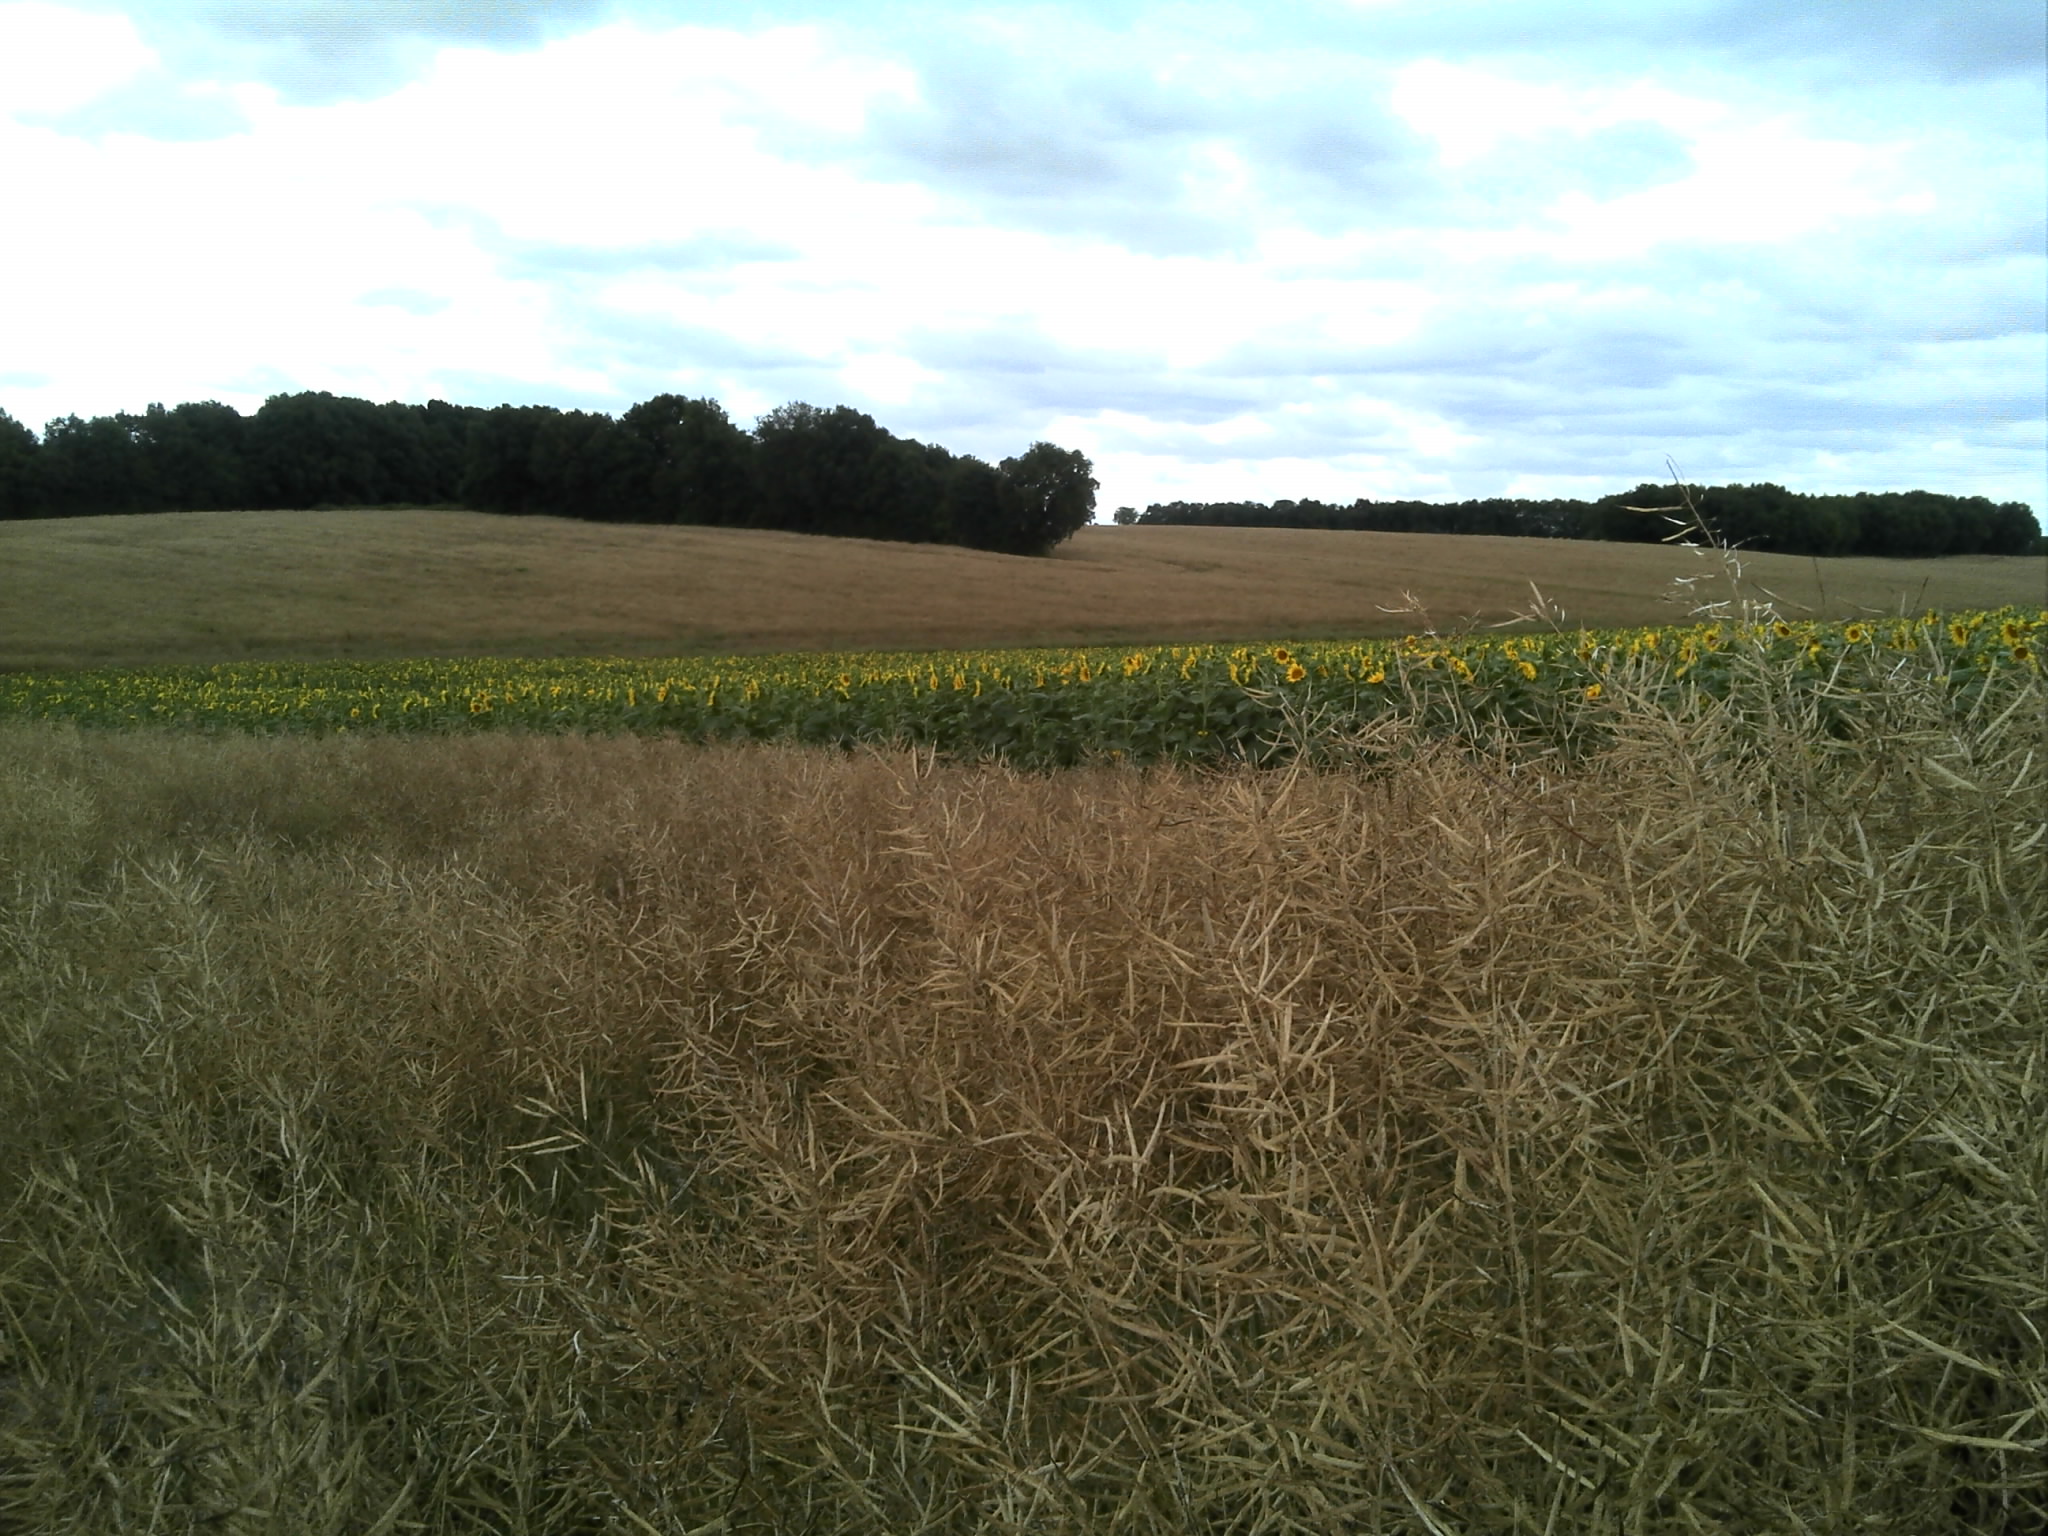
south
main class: Cropland
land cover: Rape and turnip rape
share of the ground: > 75 %
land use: Agriculture (excluding fallow land and kitchen gardens)
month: July
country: FR
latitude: 46.9211
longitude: 1.0951
